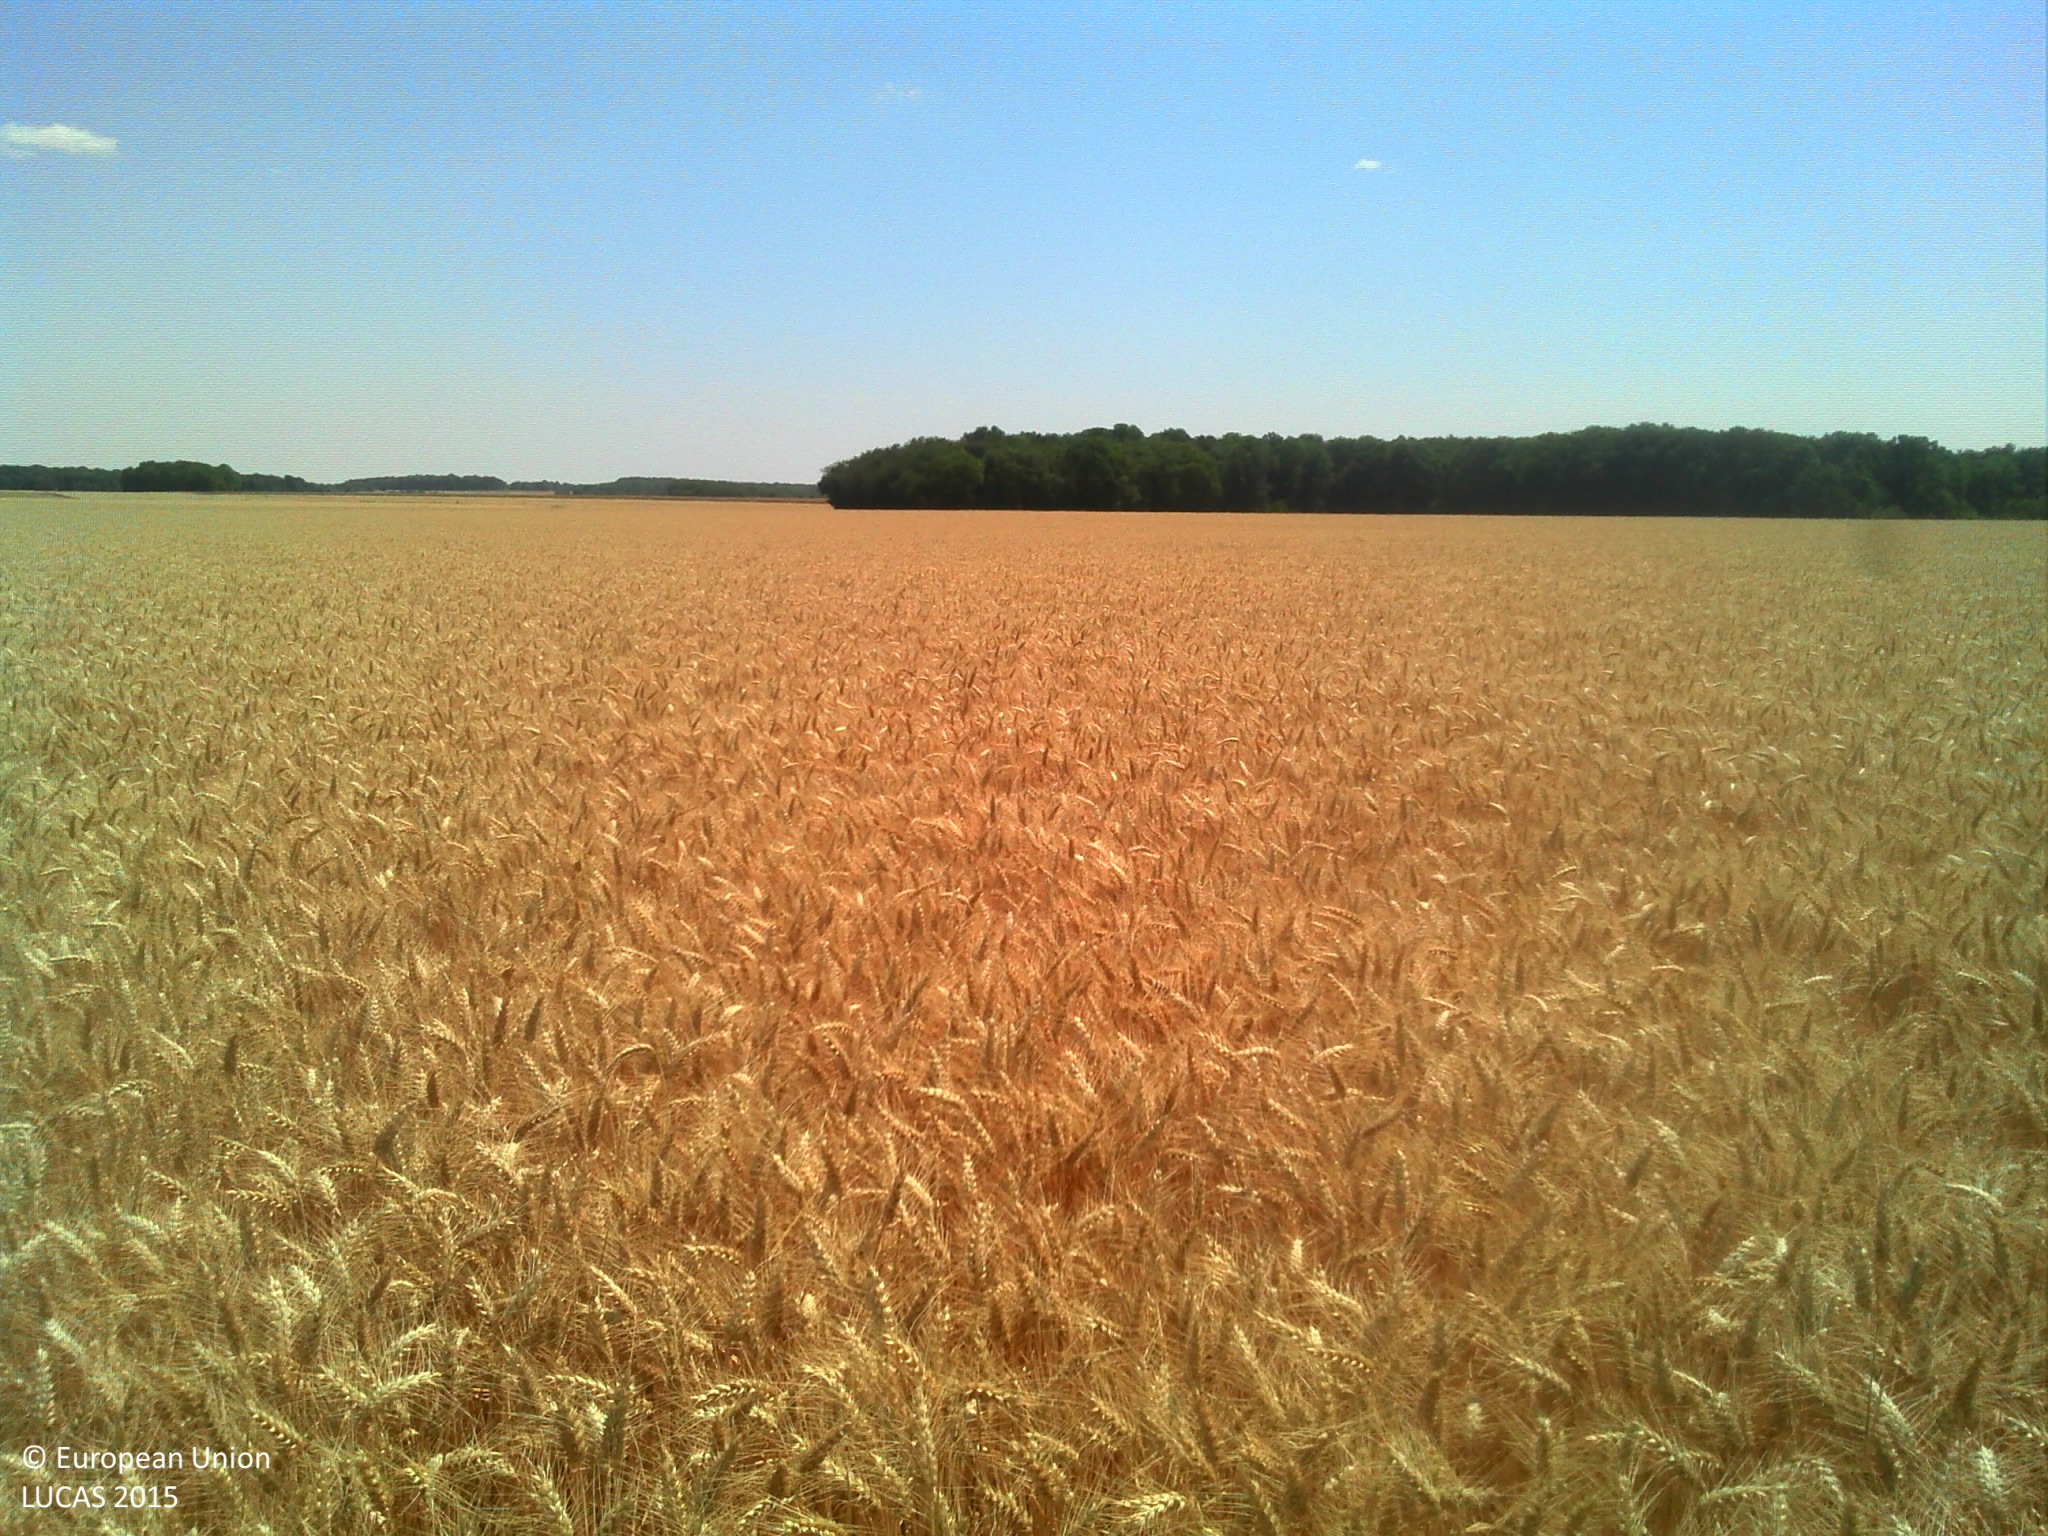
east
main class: Cropland
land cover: Common wheat
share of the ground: > 75 %
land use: Agriculture (excluding fallow land and kitchen gardens)
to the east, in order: Common wheat; Tracks; Common wheat
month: July
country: FR
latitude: 48.1494
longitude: 1.2860
